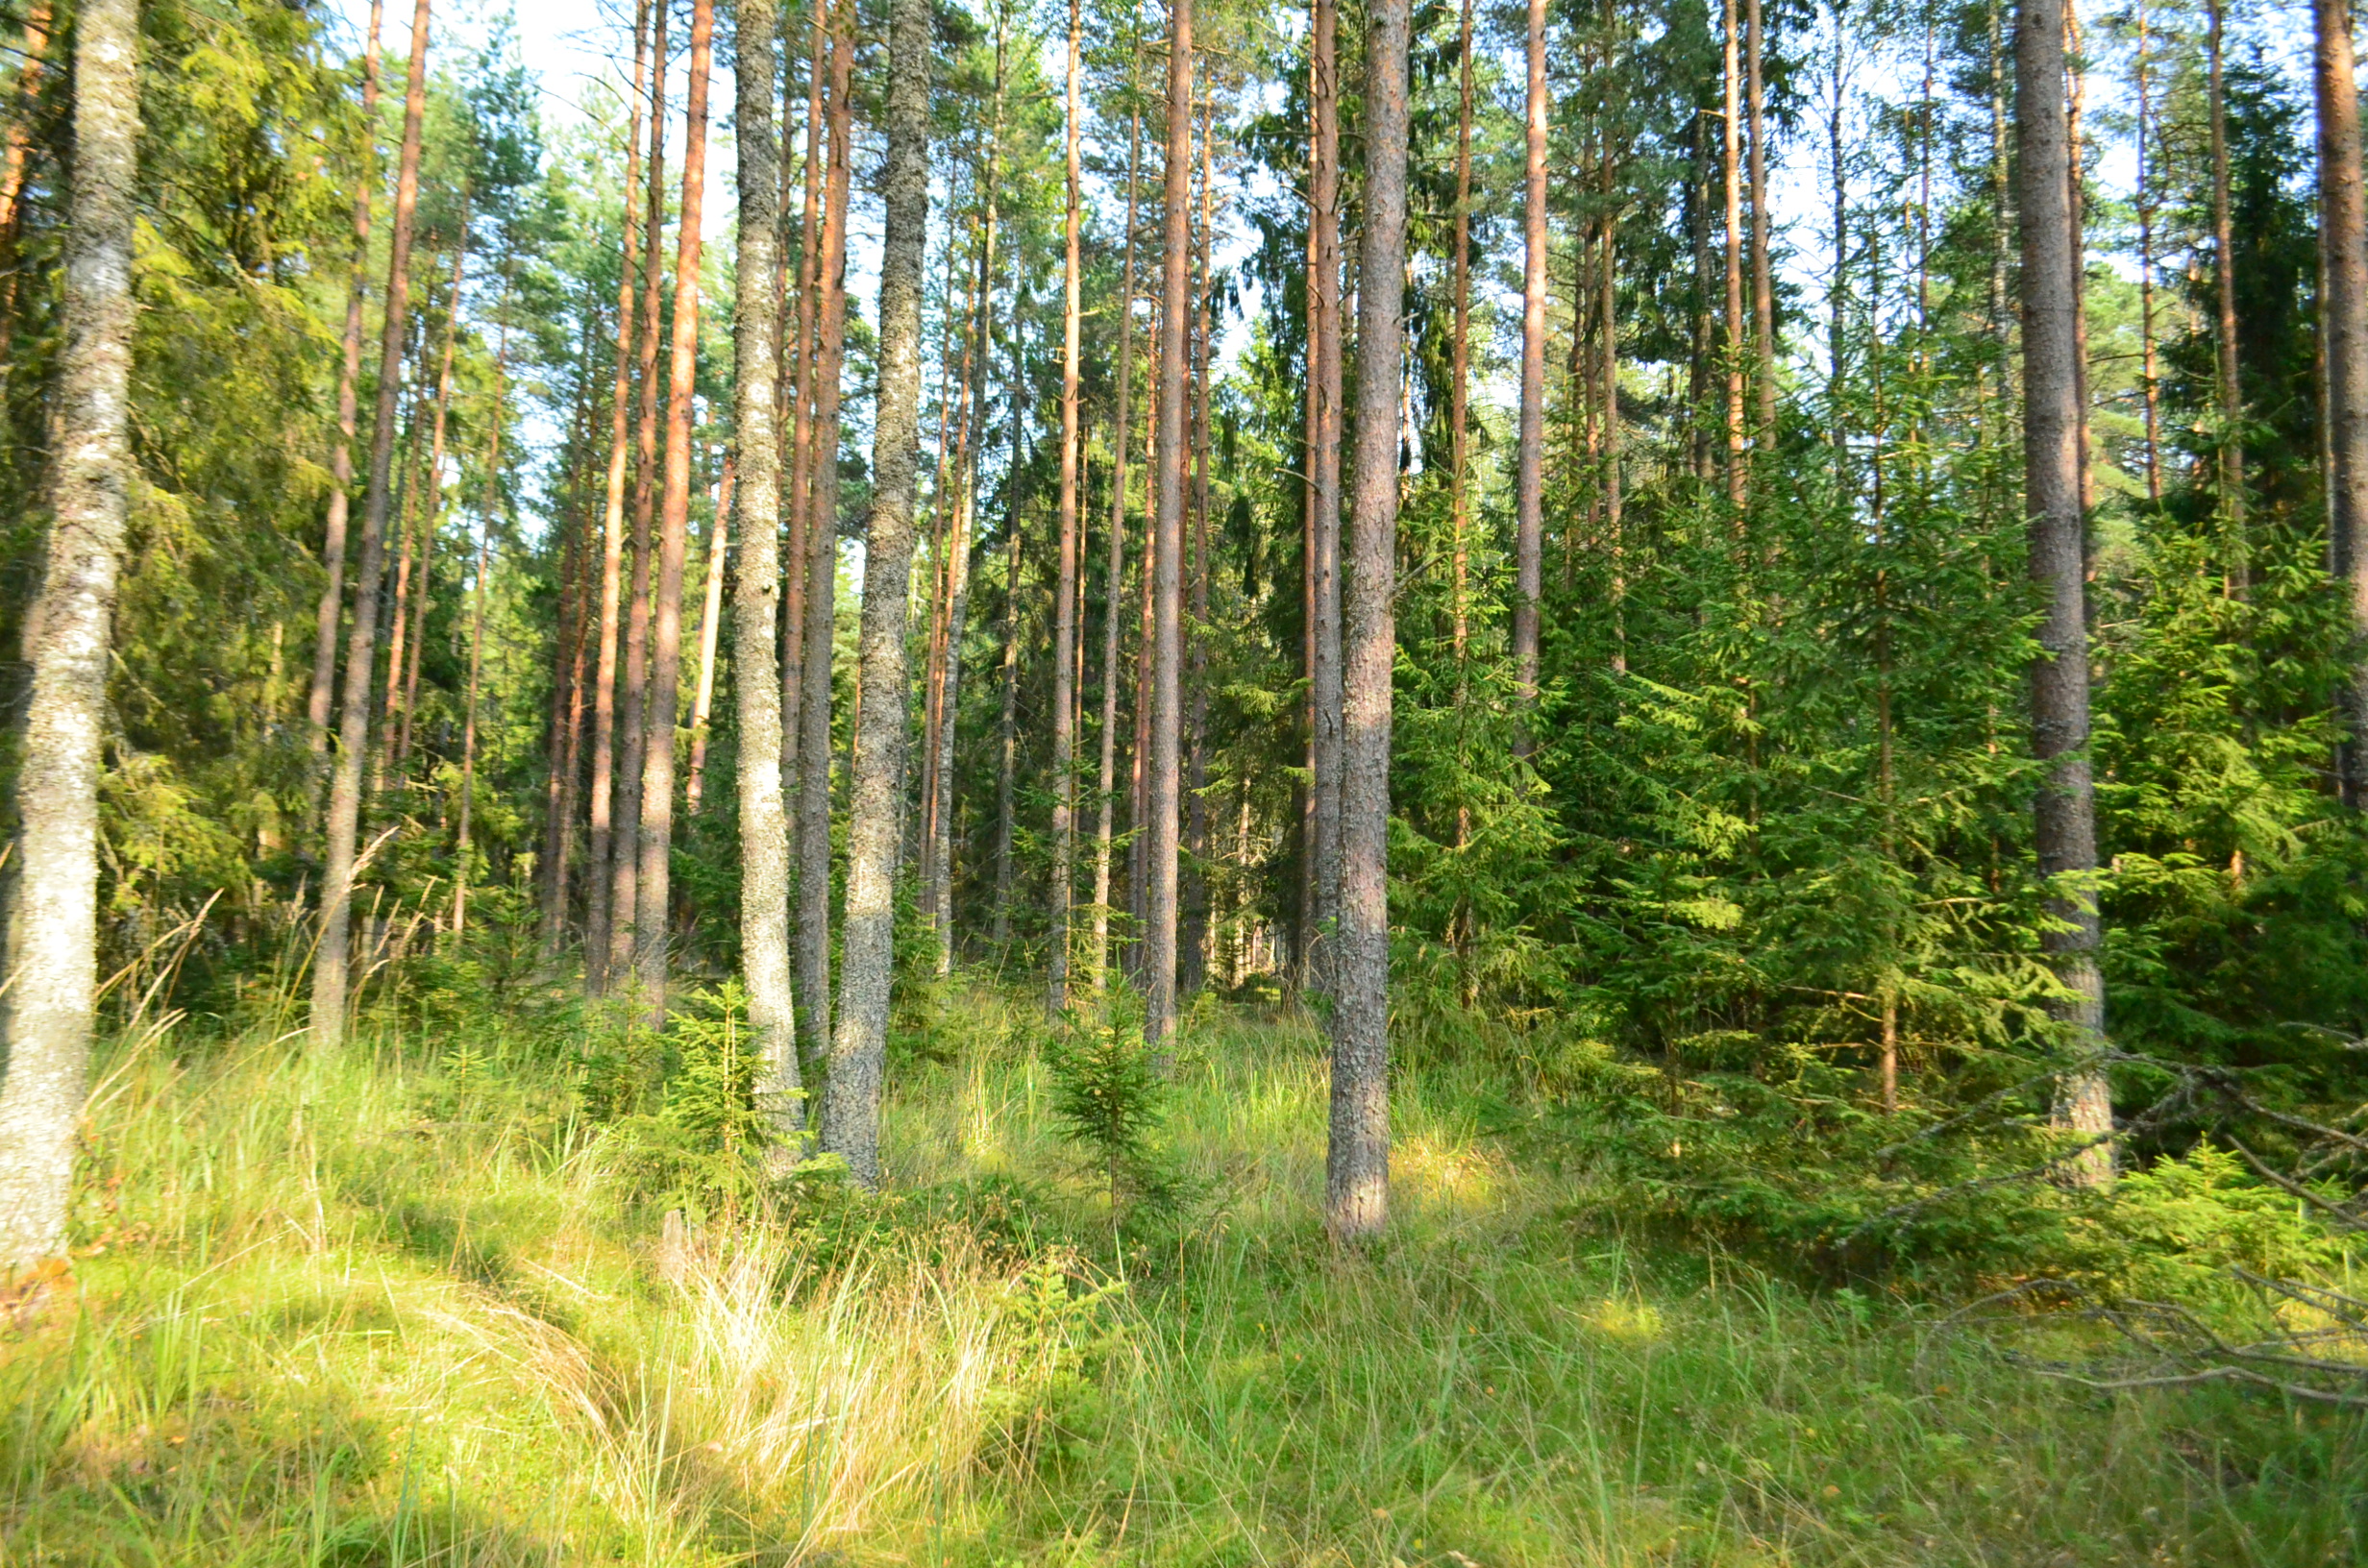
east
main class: Woodland
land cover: Other coniferous woodland
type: hemiboreal forest and nemoral coniferous forest and mixed broadleaved-coniferous forest
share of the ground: 50 - 75 %
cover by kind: coniferous forest trees 60 %, broadleaved forest trees 10 %, shrubs 10 %, herbaceous plants 10 %, lichens and mosses 10 %
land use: Forestry
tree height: > 5 m
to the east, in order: Other coniferous woodland; Tracks; Pine dominated coniferous woodland; Tracks; Other coniferous woodland; Spruce dominated coniferous woodland
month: August
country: LV
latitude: 57.2903
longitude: 21.8744
